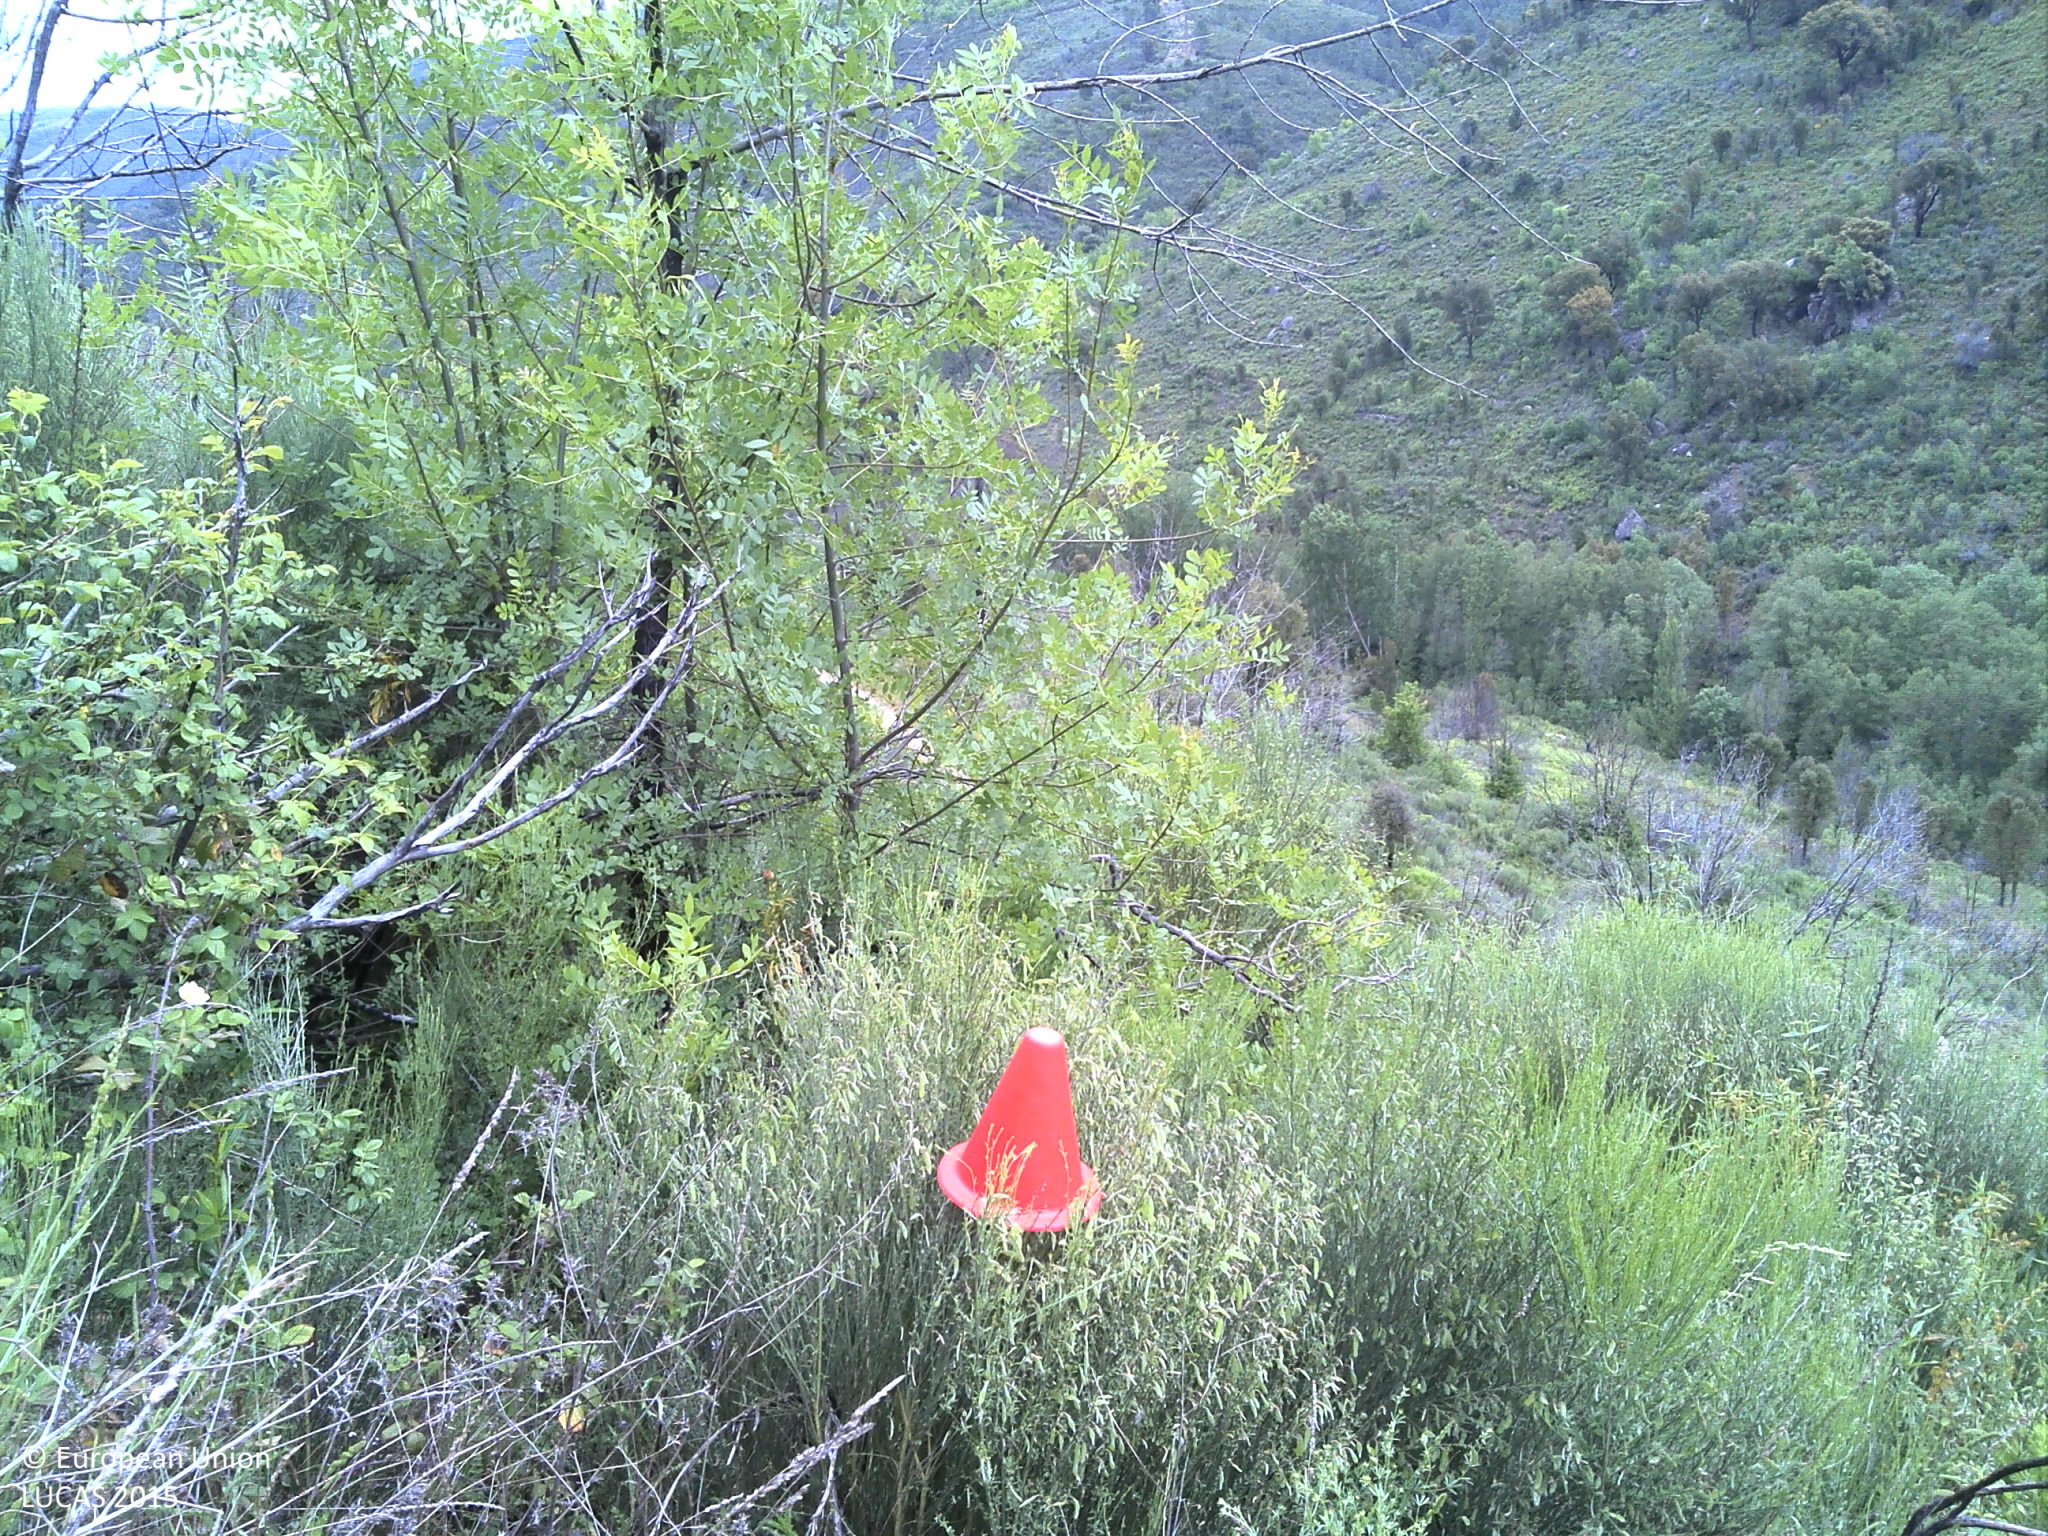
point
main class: Shrubland
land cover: Shrubland with sparse tree cover
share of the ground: > 75 %
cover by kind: shrubs 90 %, broadleaved forest trees 5 %, unconsolidated bare surface 5 %
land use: Forestry
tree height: < 5 m
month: May
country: PT
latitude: 41.6799
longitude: -7.0197
